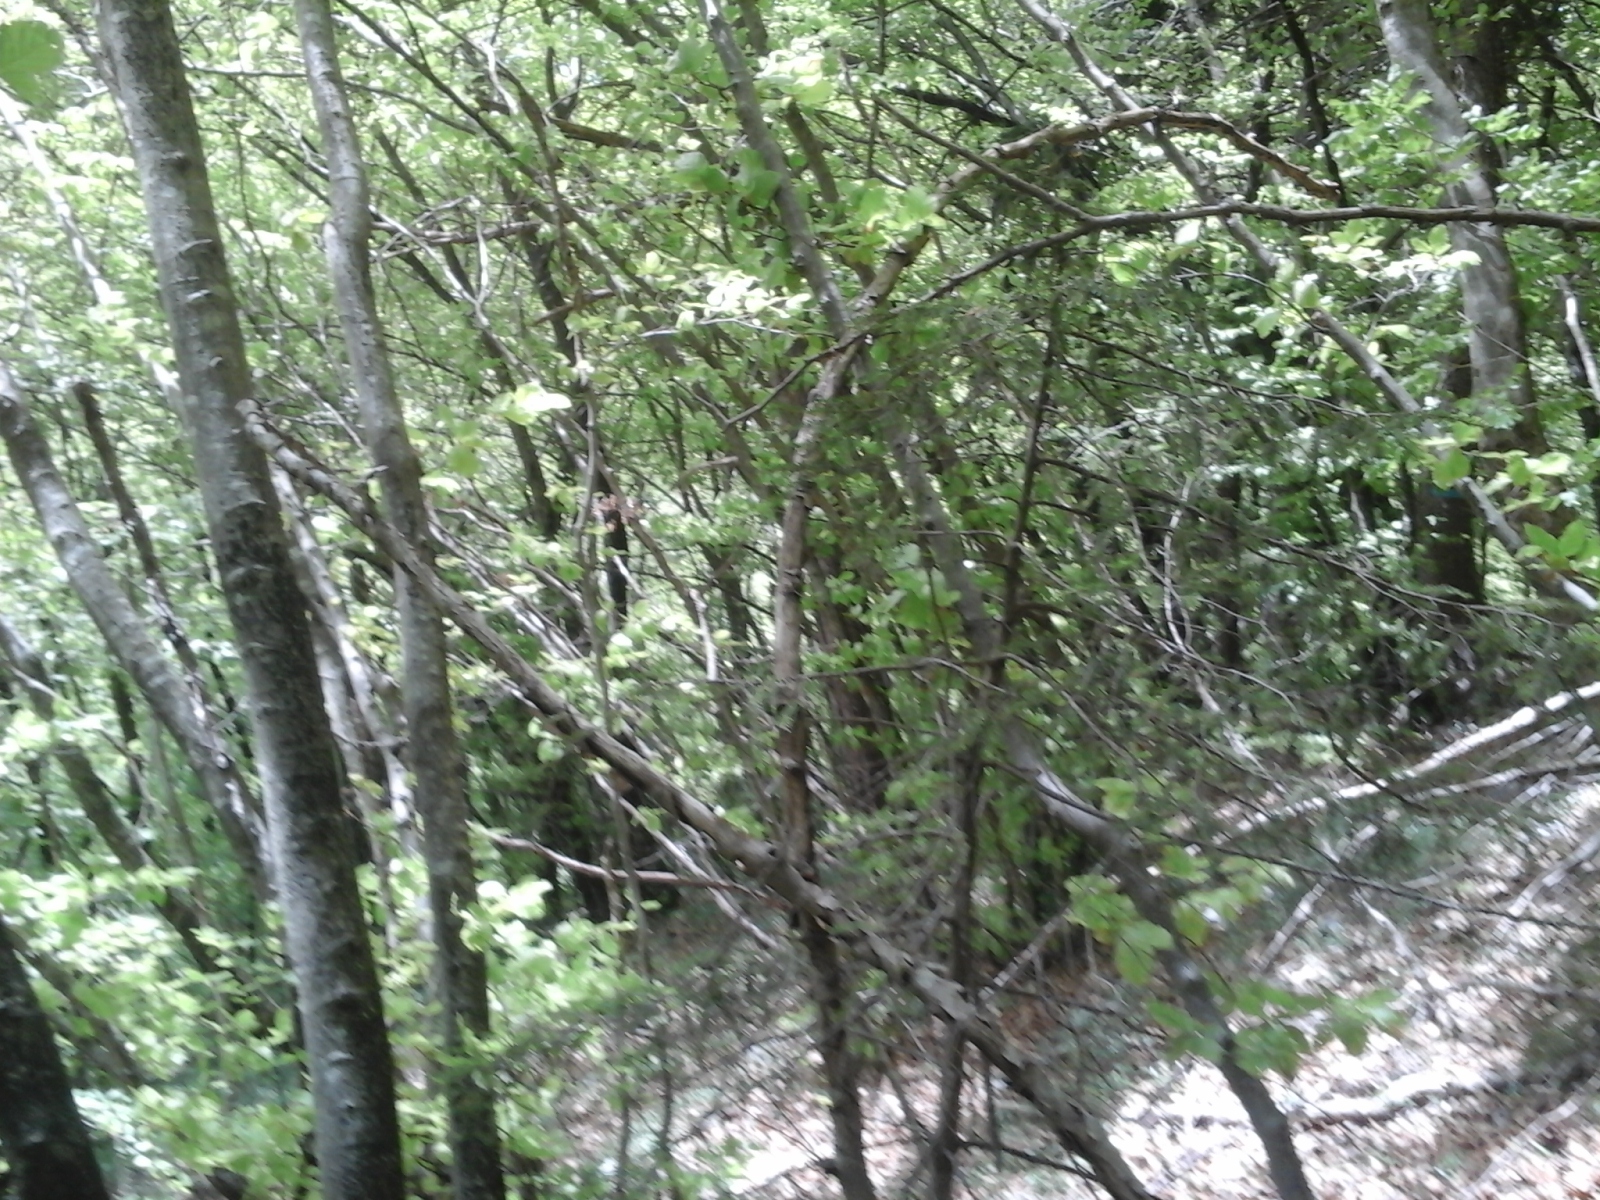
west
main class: Woodland
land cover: Broadleaved woodland
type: mountainous beech forest
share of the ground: > 75 %
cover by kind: broadleaved forest trees 100 %
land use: Forestry
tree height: > 5 m
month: May
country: IT
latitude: 45.8985
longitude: 10.7078
